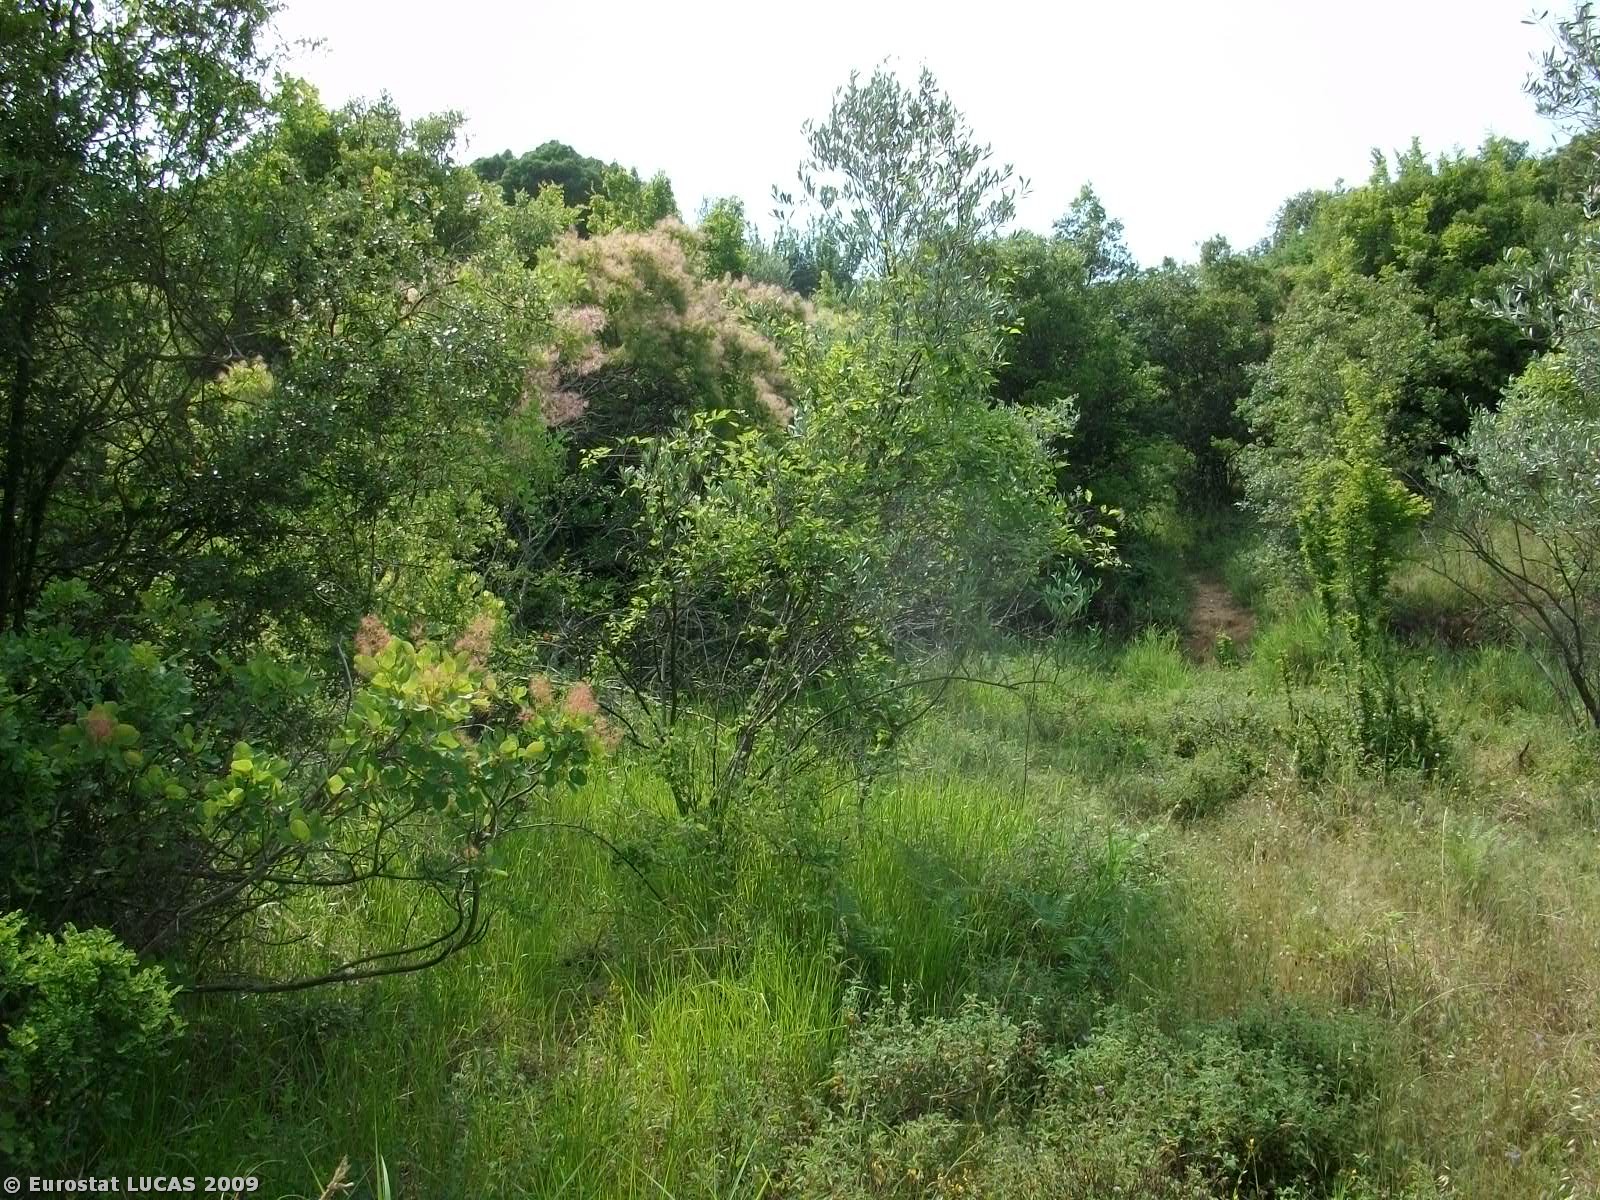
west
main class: Cropland
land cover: Olive groves
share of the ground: < 10 %
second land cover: Grassland with sparse tree/shrub cover
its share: > 75 %
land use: Agriculture (excluding fallow land and kitchen gardens)
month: June
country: GR
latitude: 39.6920
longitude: 22.8569
